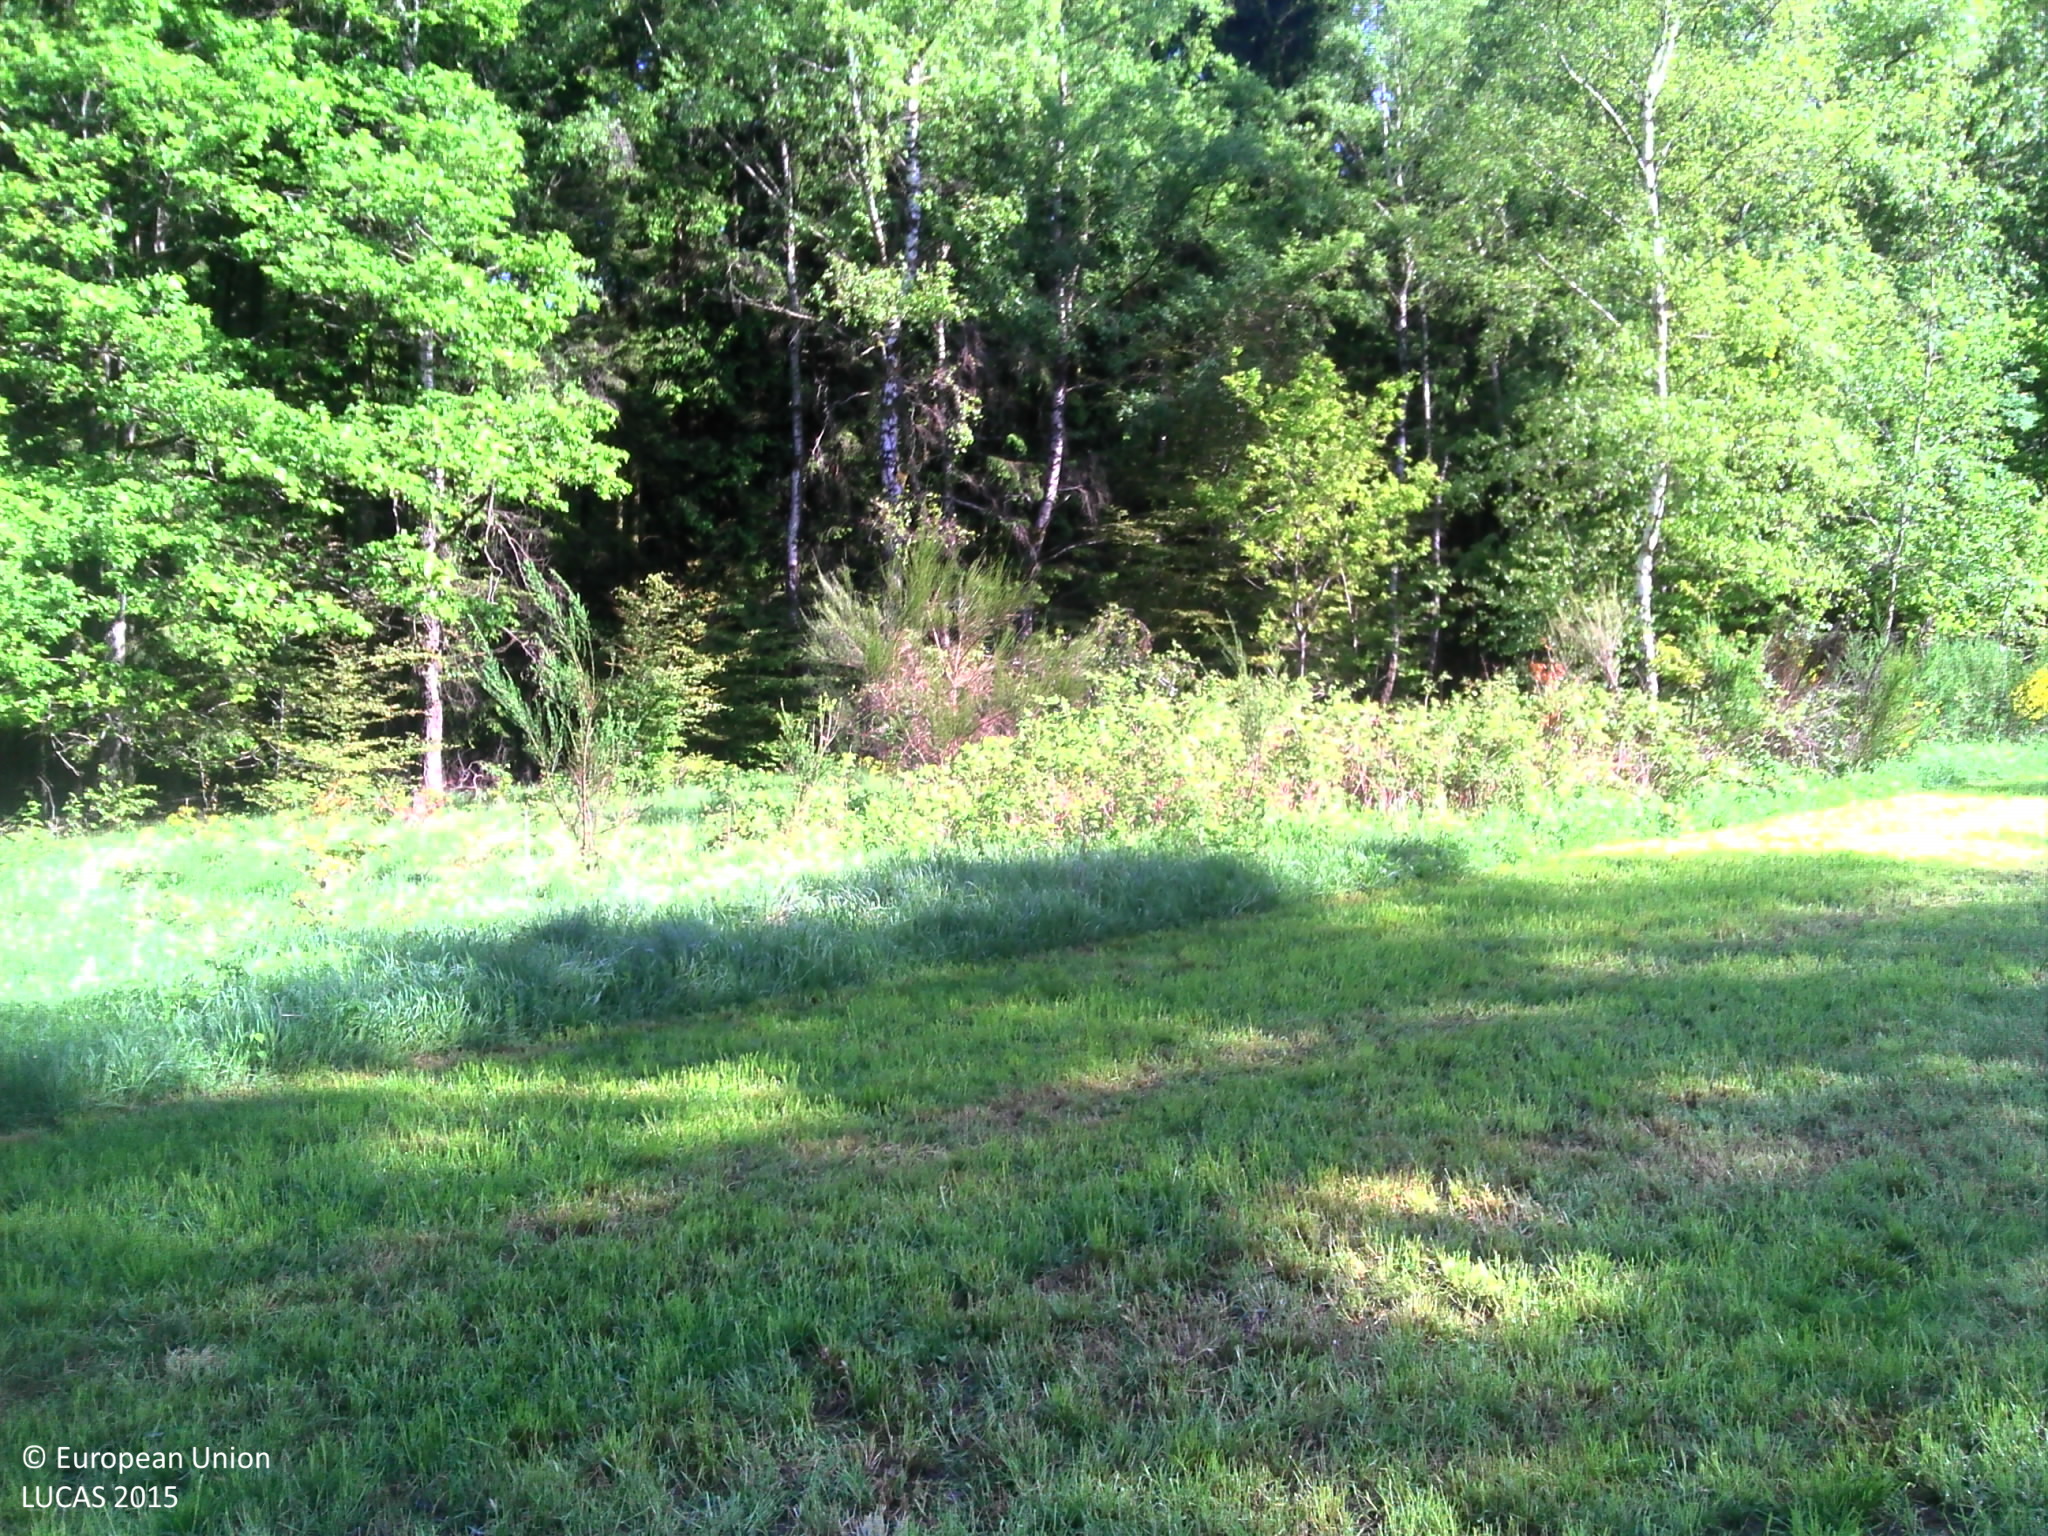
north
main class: Grassland
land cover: Grassland without tree/shrub cover
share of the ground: > 75 %
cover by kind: herbaceous plants 100 %
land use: Agriculture (excluding fallow land and kitchen gardens)
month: May
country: LU
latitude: 49.8373
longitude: 5.8138
